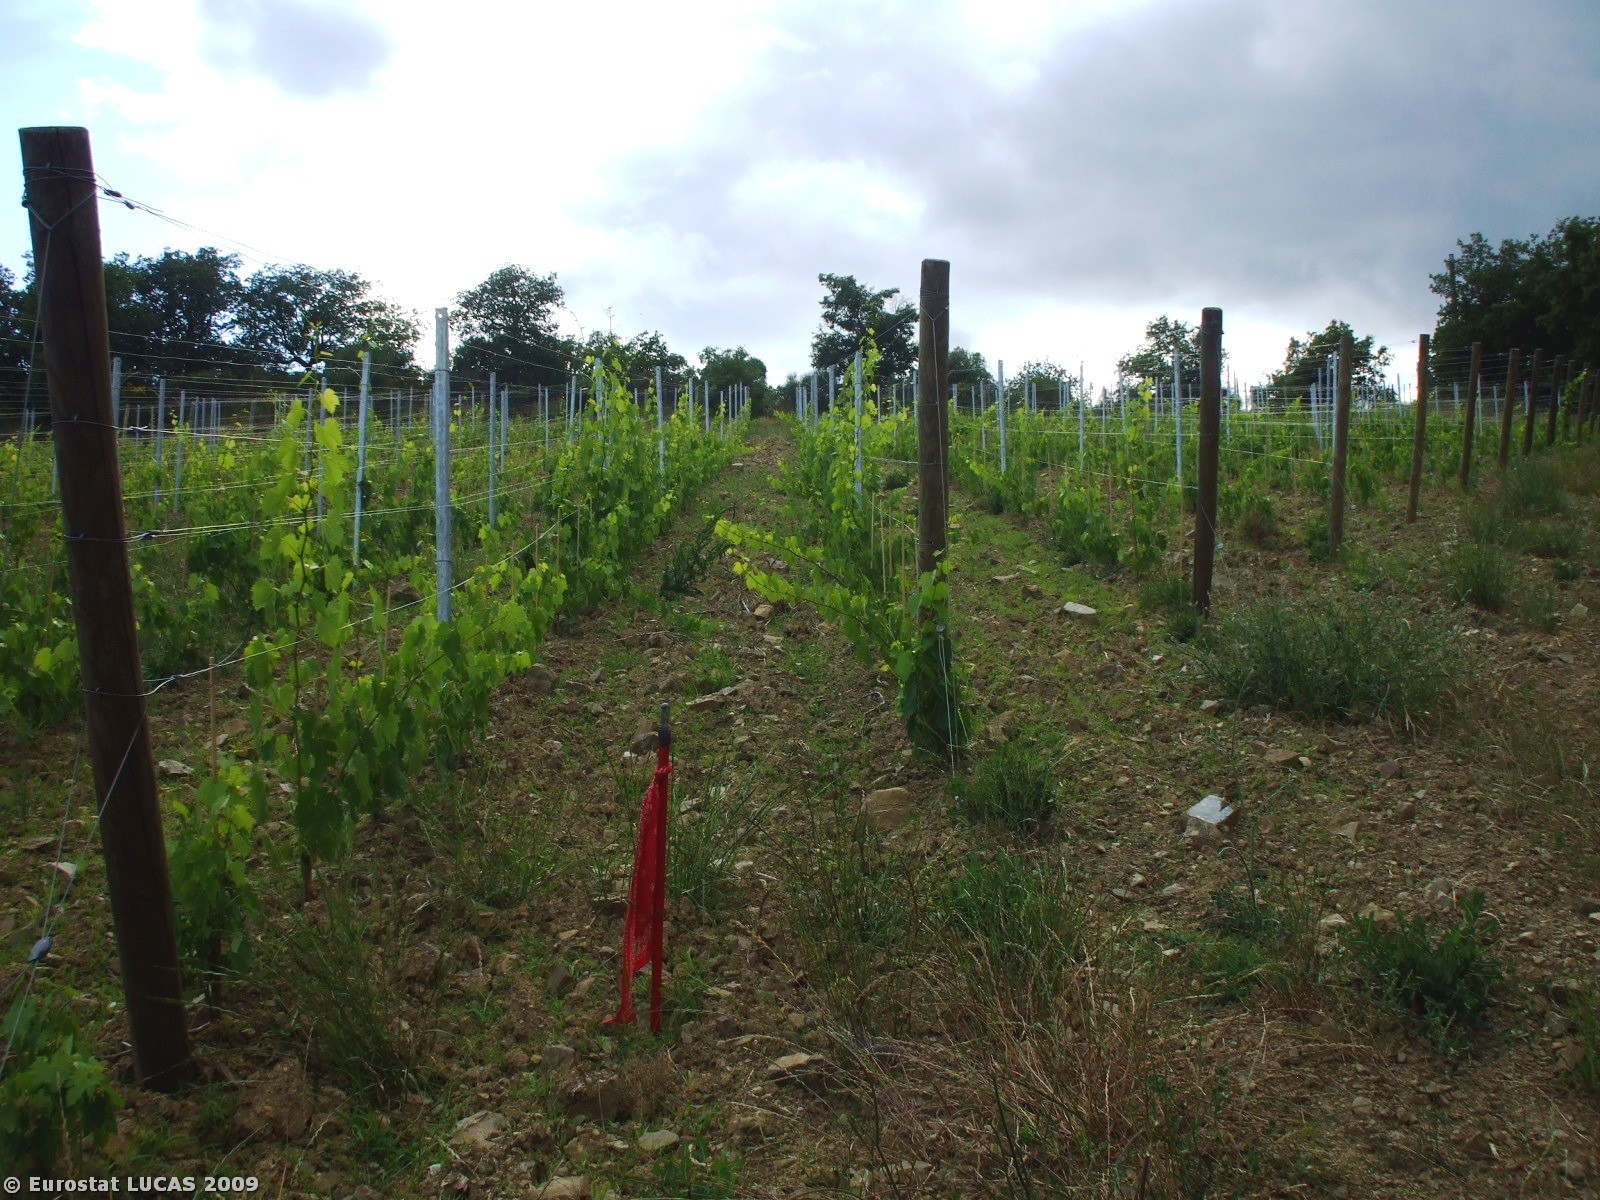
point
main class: Cropland
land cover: Vineyards
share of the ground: 10 - 25 %
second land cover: Grassland with sparse tree/shrub cover
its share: > 75 %
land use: Agriculture (excluding fallow land and kitchen gardens)
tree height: < 5 m
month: June
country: IT
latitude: 43.3804
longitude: 11.6863
